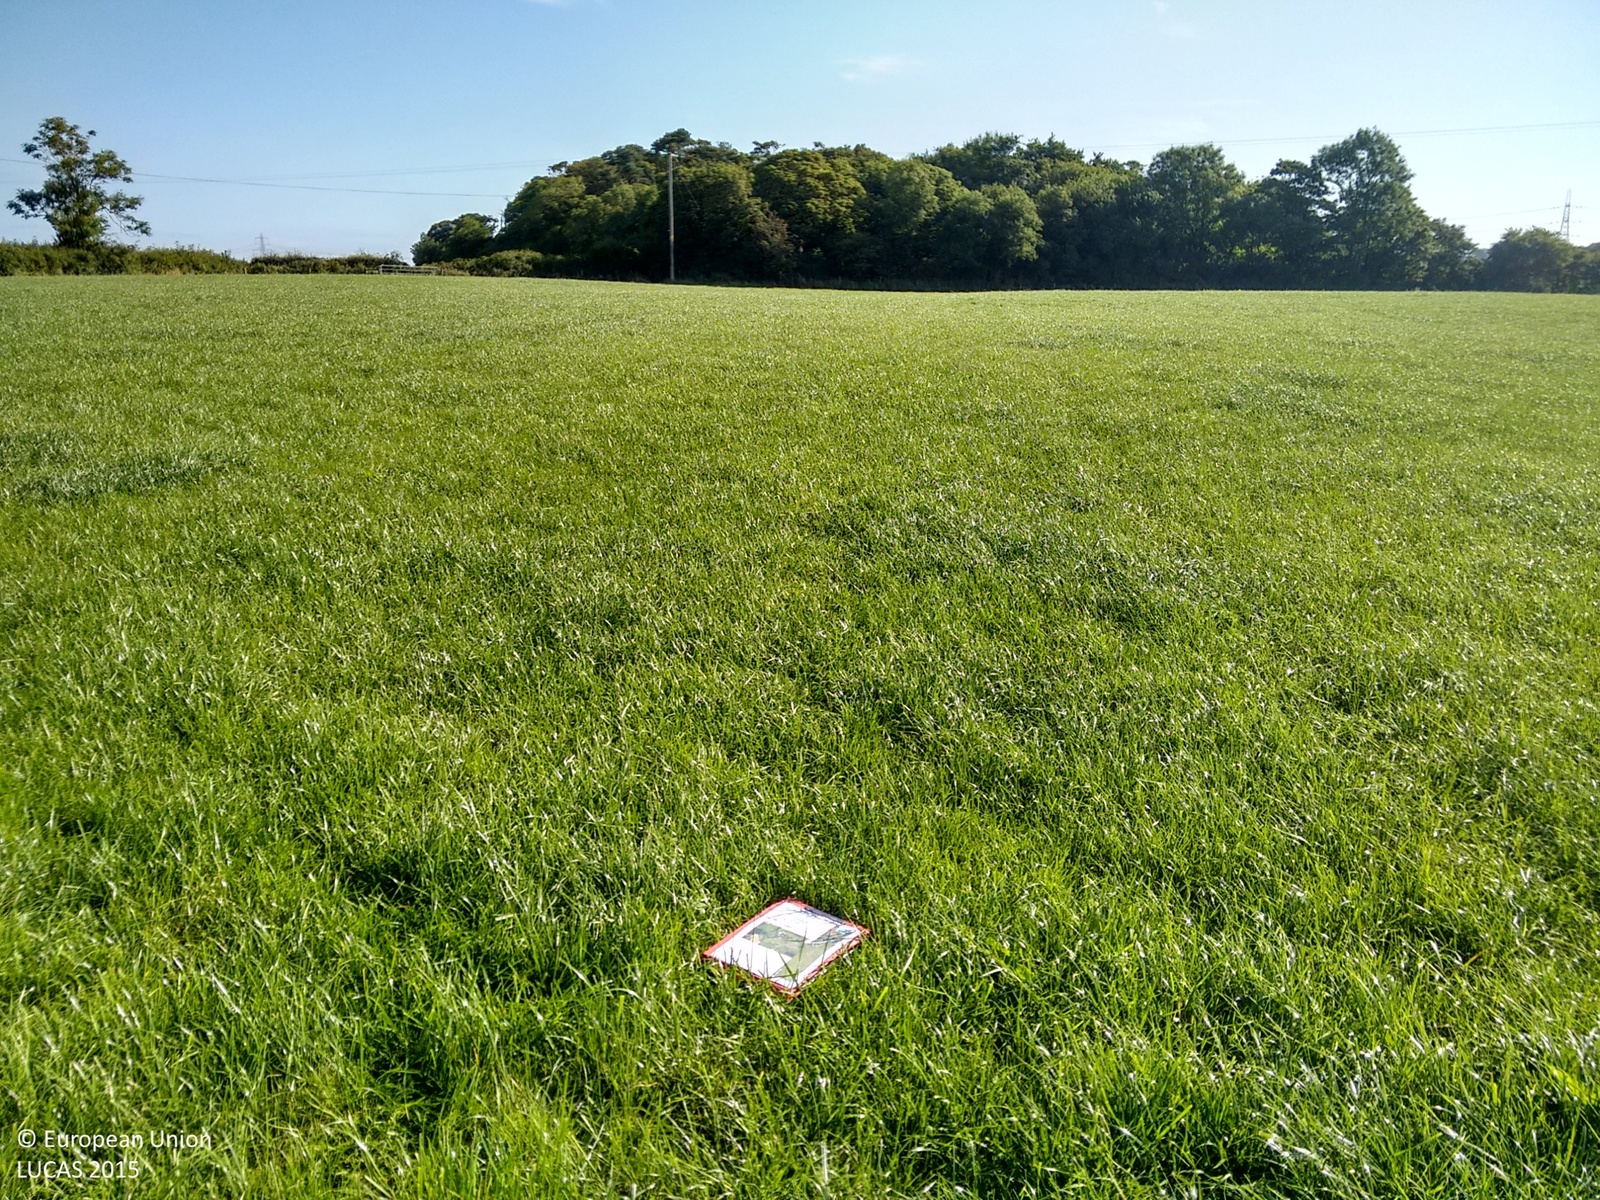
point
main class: Grassland
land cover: Grassland without tree/shrub cover
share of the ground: > 75 %
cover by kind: herbaceous plants 100 %
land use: Agriculture (excluding fallow land and kitchen gardens)
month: August
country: GB
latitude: 53.2955
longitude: -4.3088
